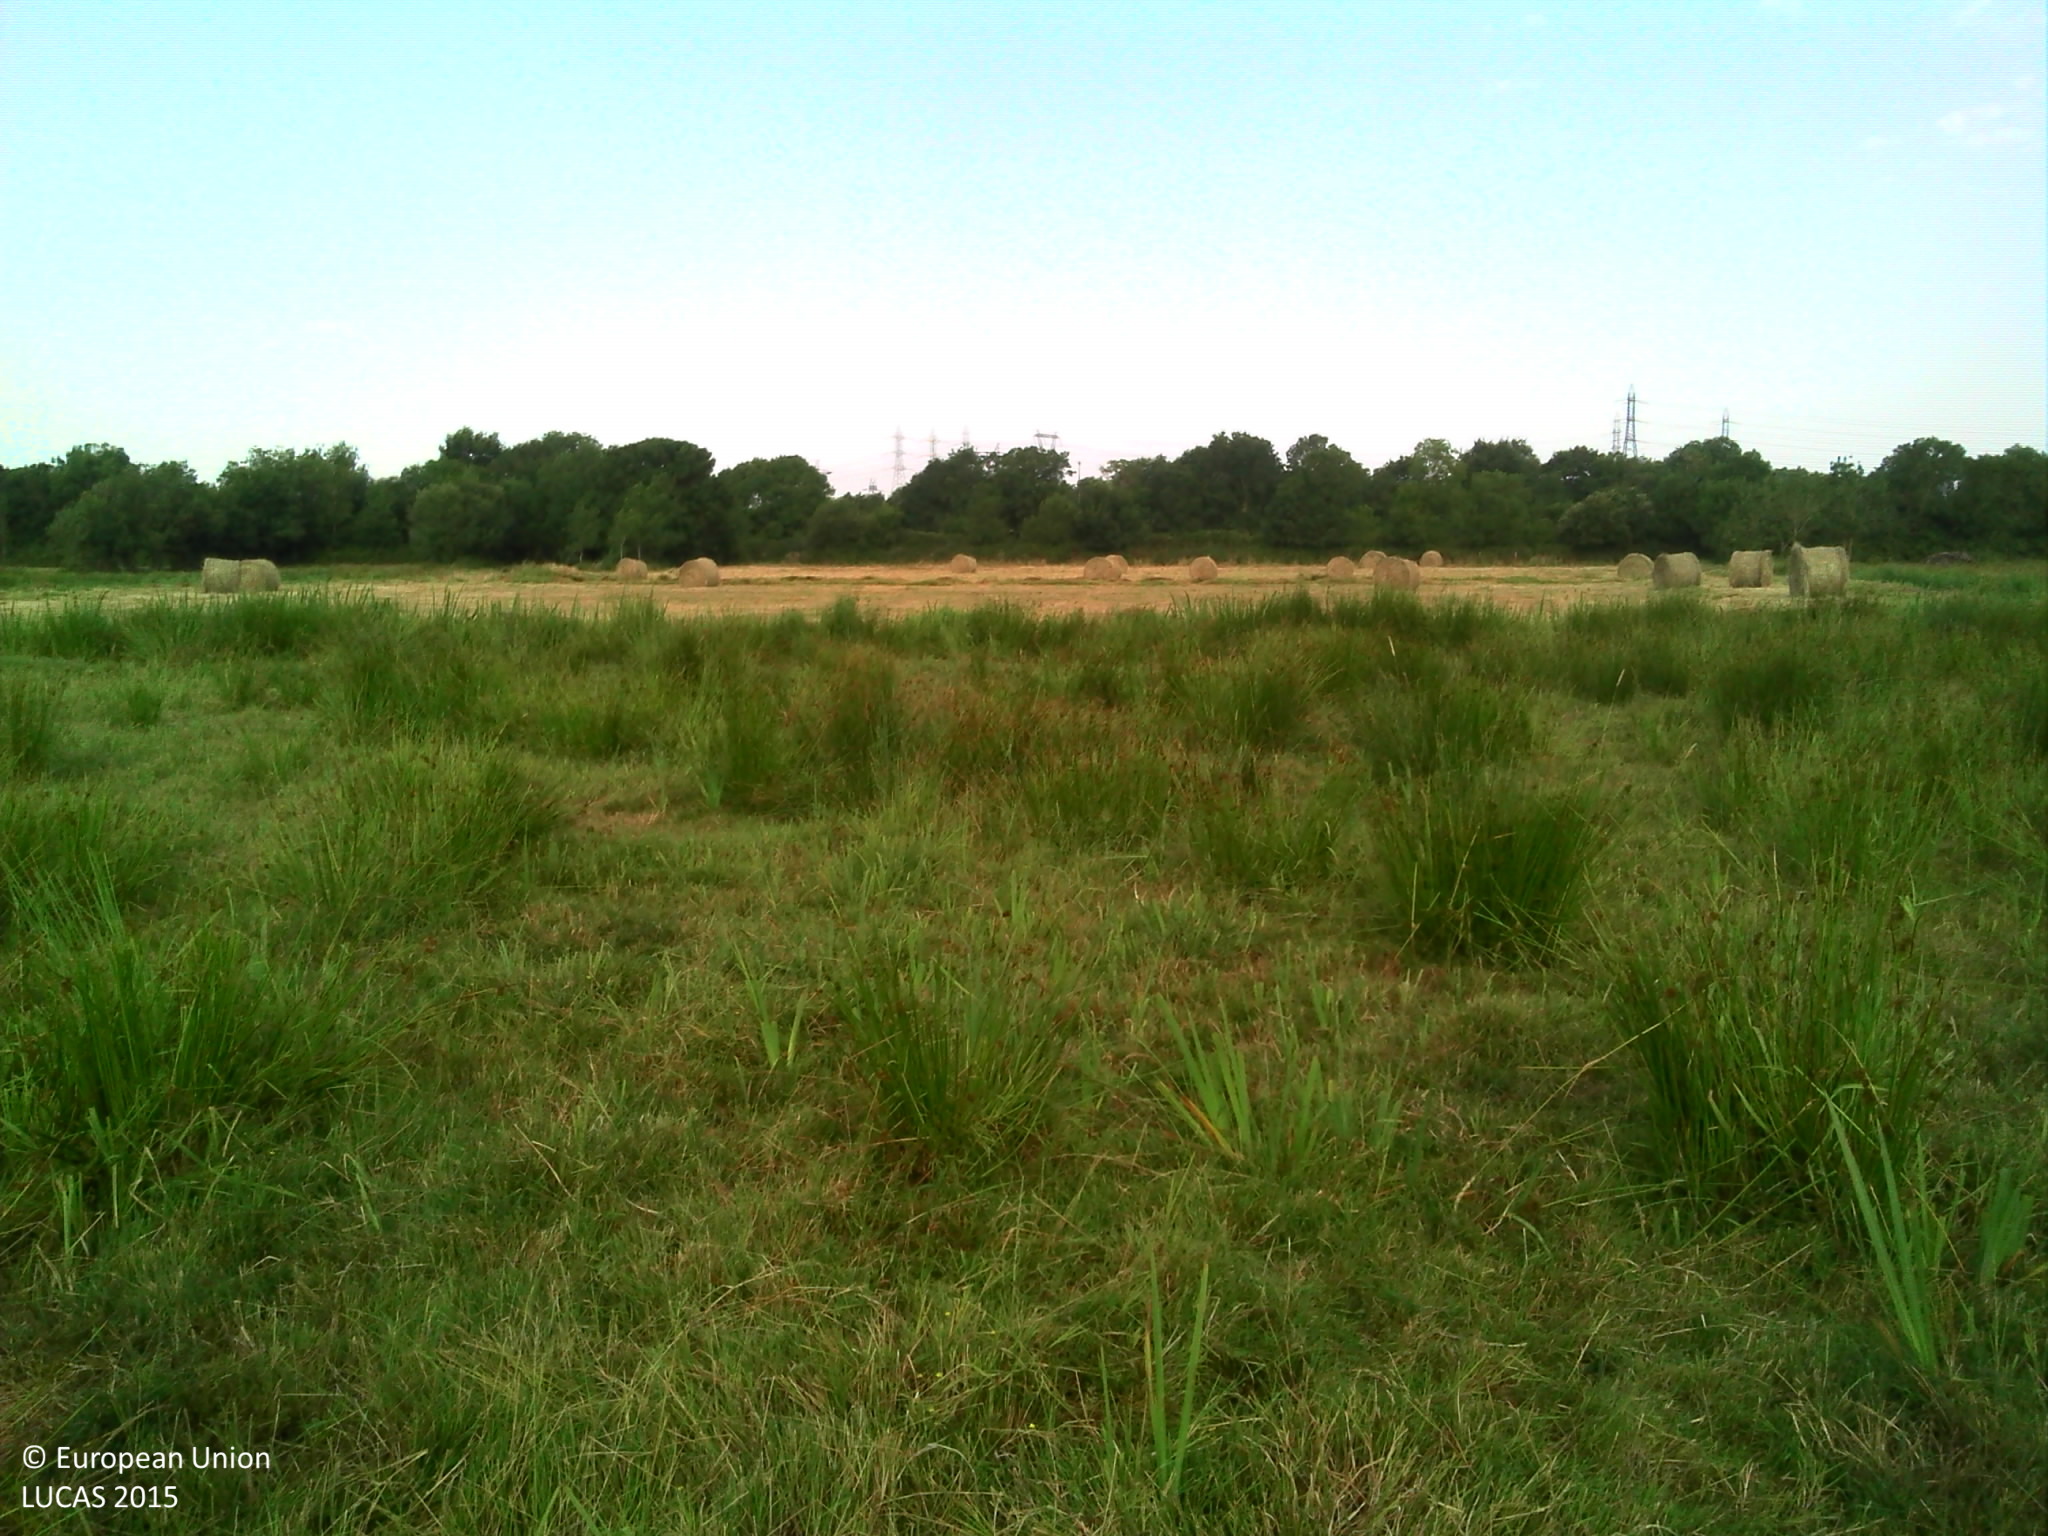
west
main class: Grassland
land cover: Grassland without tree/shrub cover
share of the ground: > 75 %
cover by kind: herbaceous plants 100 %
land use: Agriculture (excluding fallow land and kitchen gardens)
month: July
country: FR
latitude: 47.2903
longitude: -1.8545
